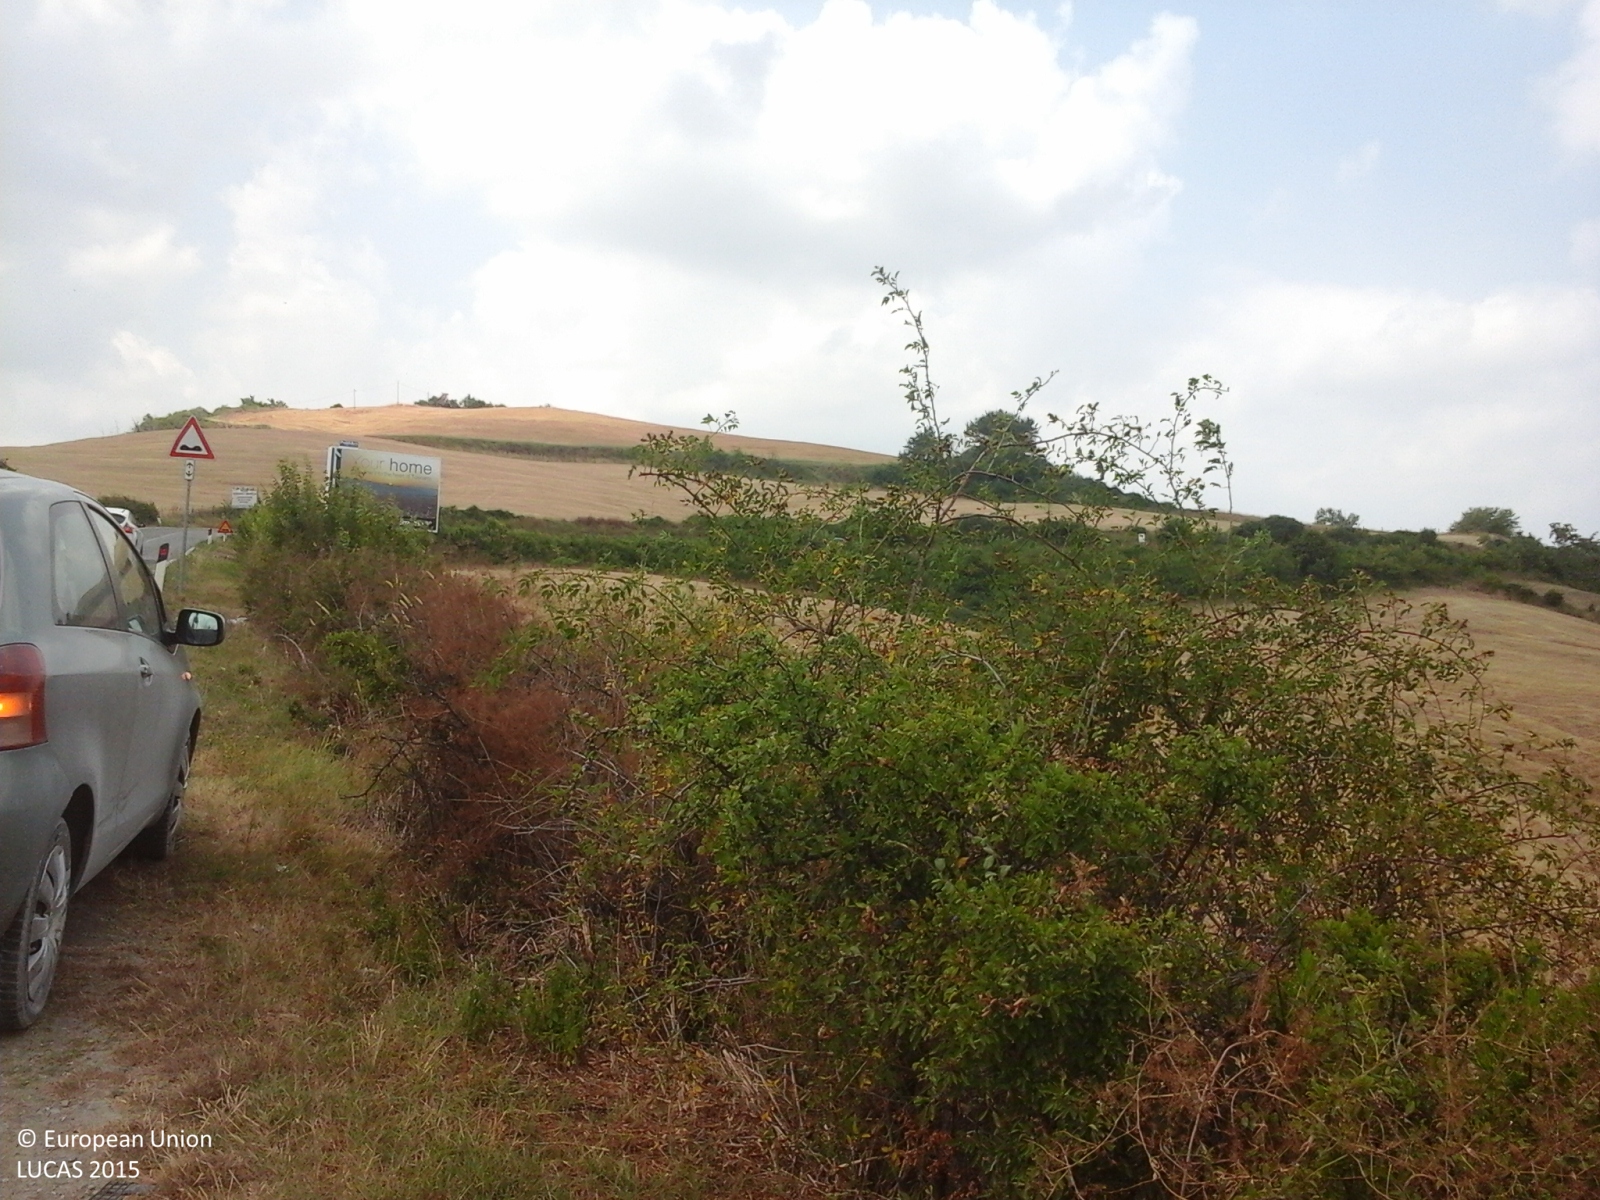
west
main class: Woodland
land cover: Broadleaved woodland
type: thermophilous deciduous forest
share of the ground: > 75 %
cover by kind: broadleaved forest trees 100 %
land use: Forestry
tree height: > 5 m
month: July
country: IT
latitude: 43.3901
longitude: 10.9232
